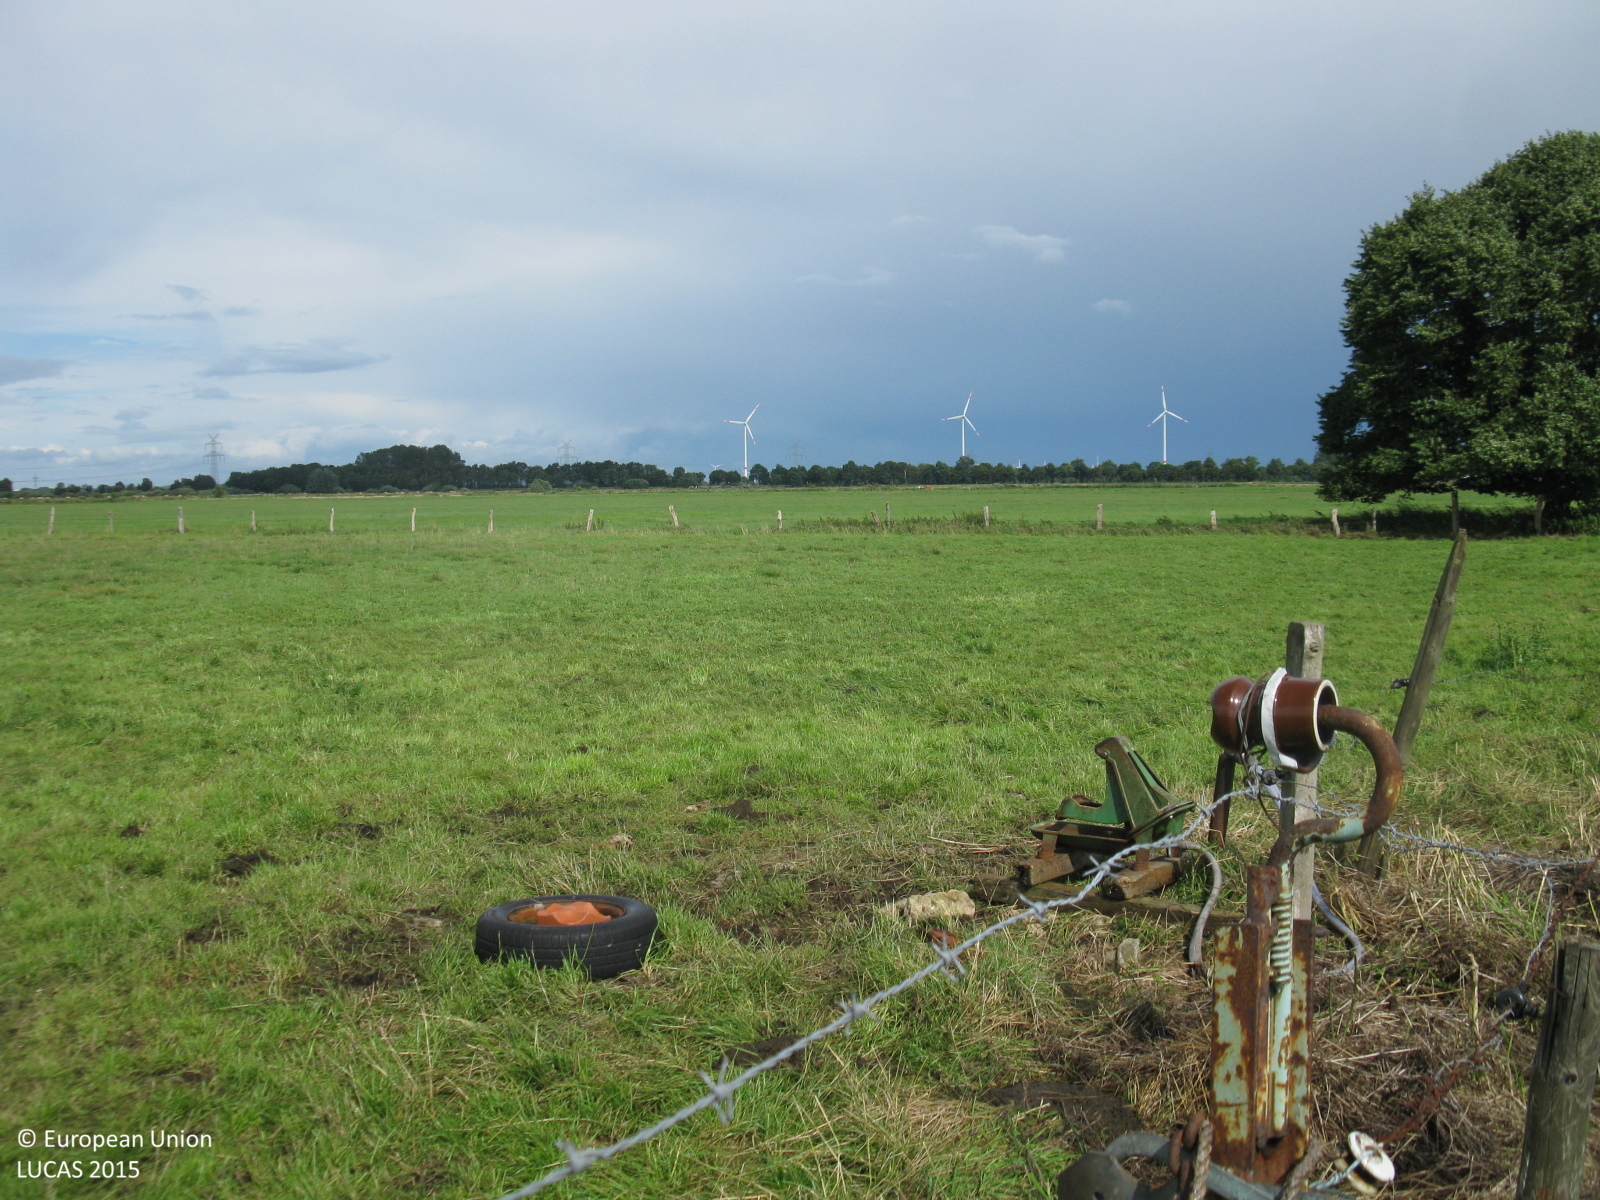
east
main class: Grassland
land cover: Grassland without tree/shrub cover
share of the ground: > 75 %
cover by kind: herbaceous plants 100 %
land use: Agriculture (excluding fallow land and kitchen gardens)
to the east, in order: Grassland without tree/shrub cover; Fences; Grassland without tree/shrub cover
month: July
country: DE
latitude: 53.1233
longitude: 8.5212
